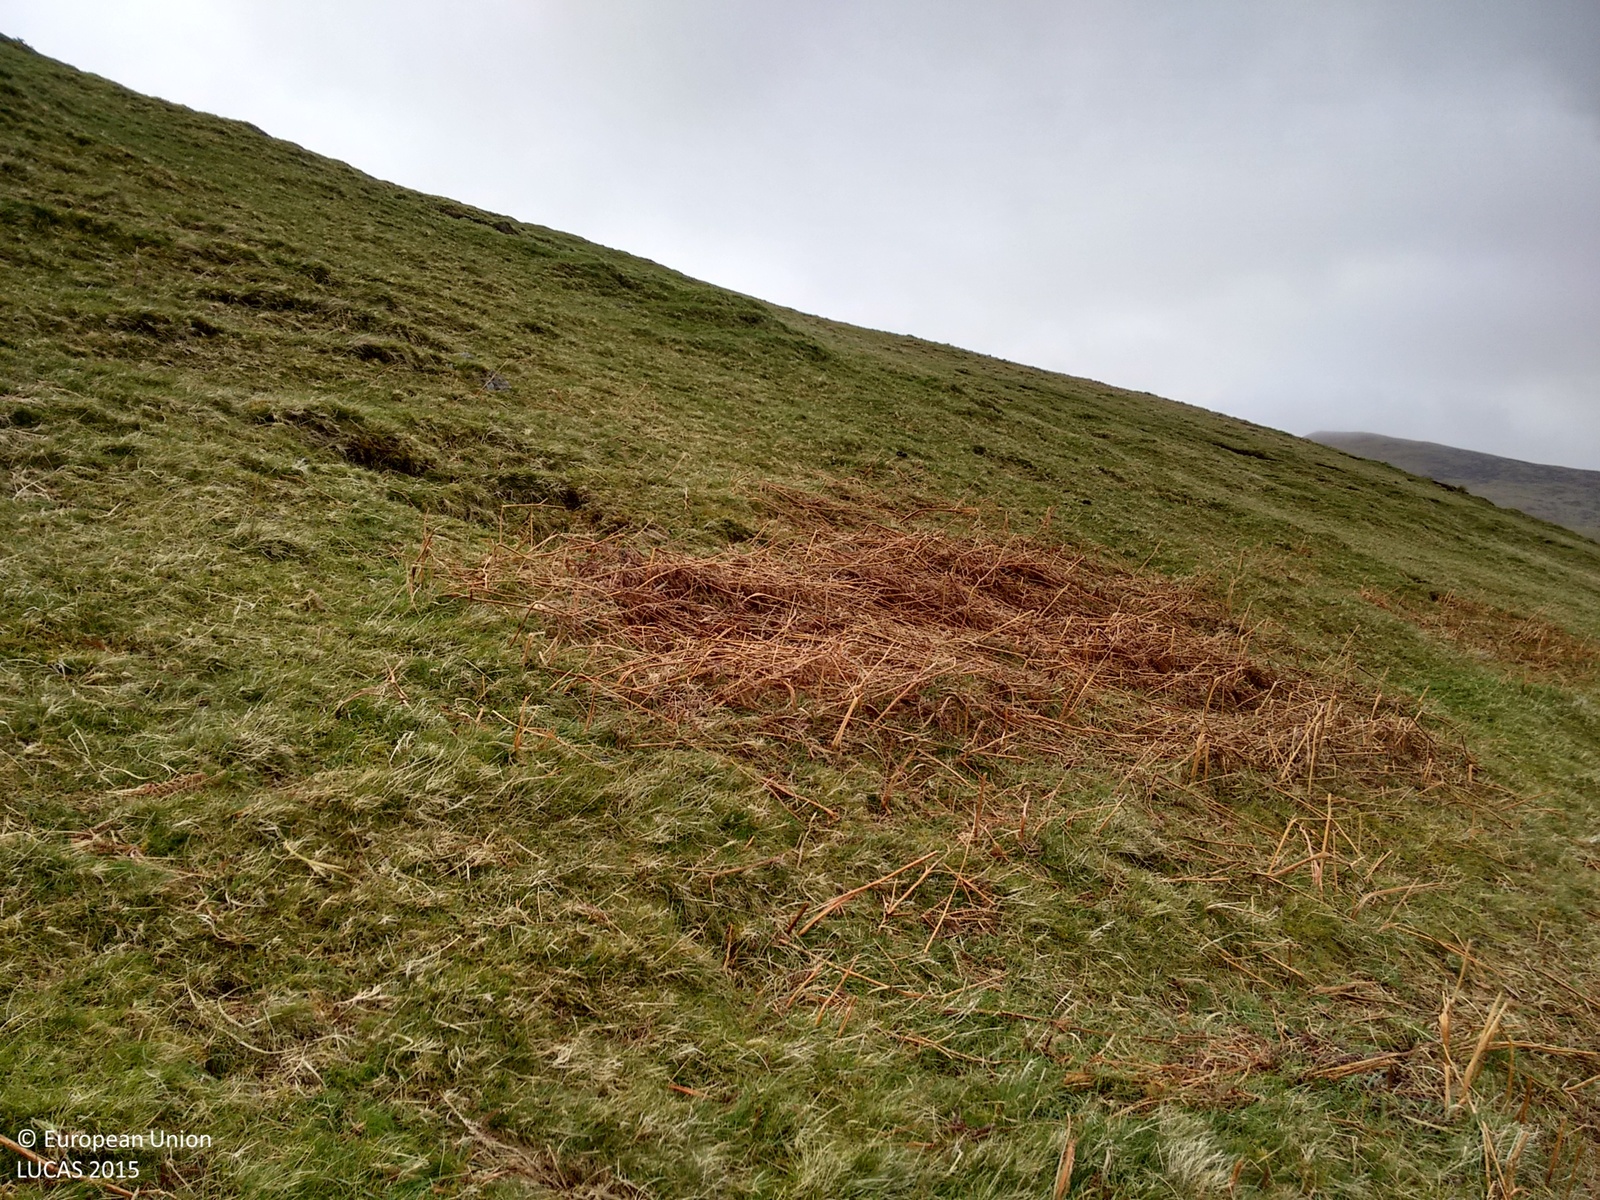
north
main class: Grassland
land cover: Grassland without tree/shrub cover
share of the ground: > 75 %
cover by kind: herbaceous plants 100 %
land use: Agriculture (excluding fallow land and kitchen gardens)
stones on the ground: < 10 %
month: May
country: GB
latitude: 55.8193
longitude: -3.3052
